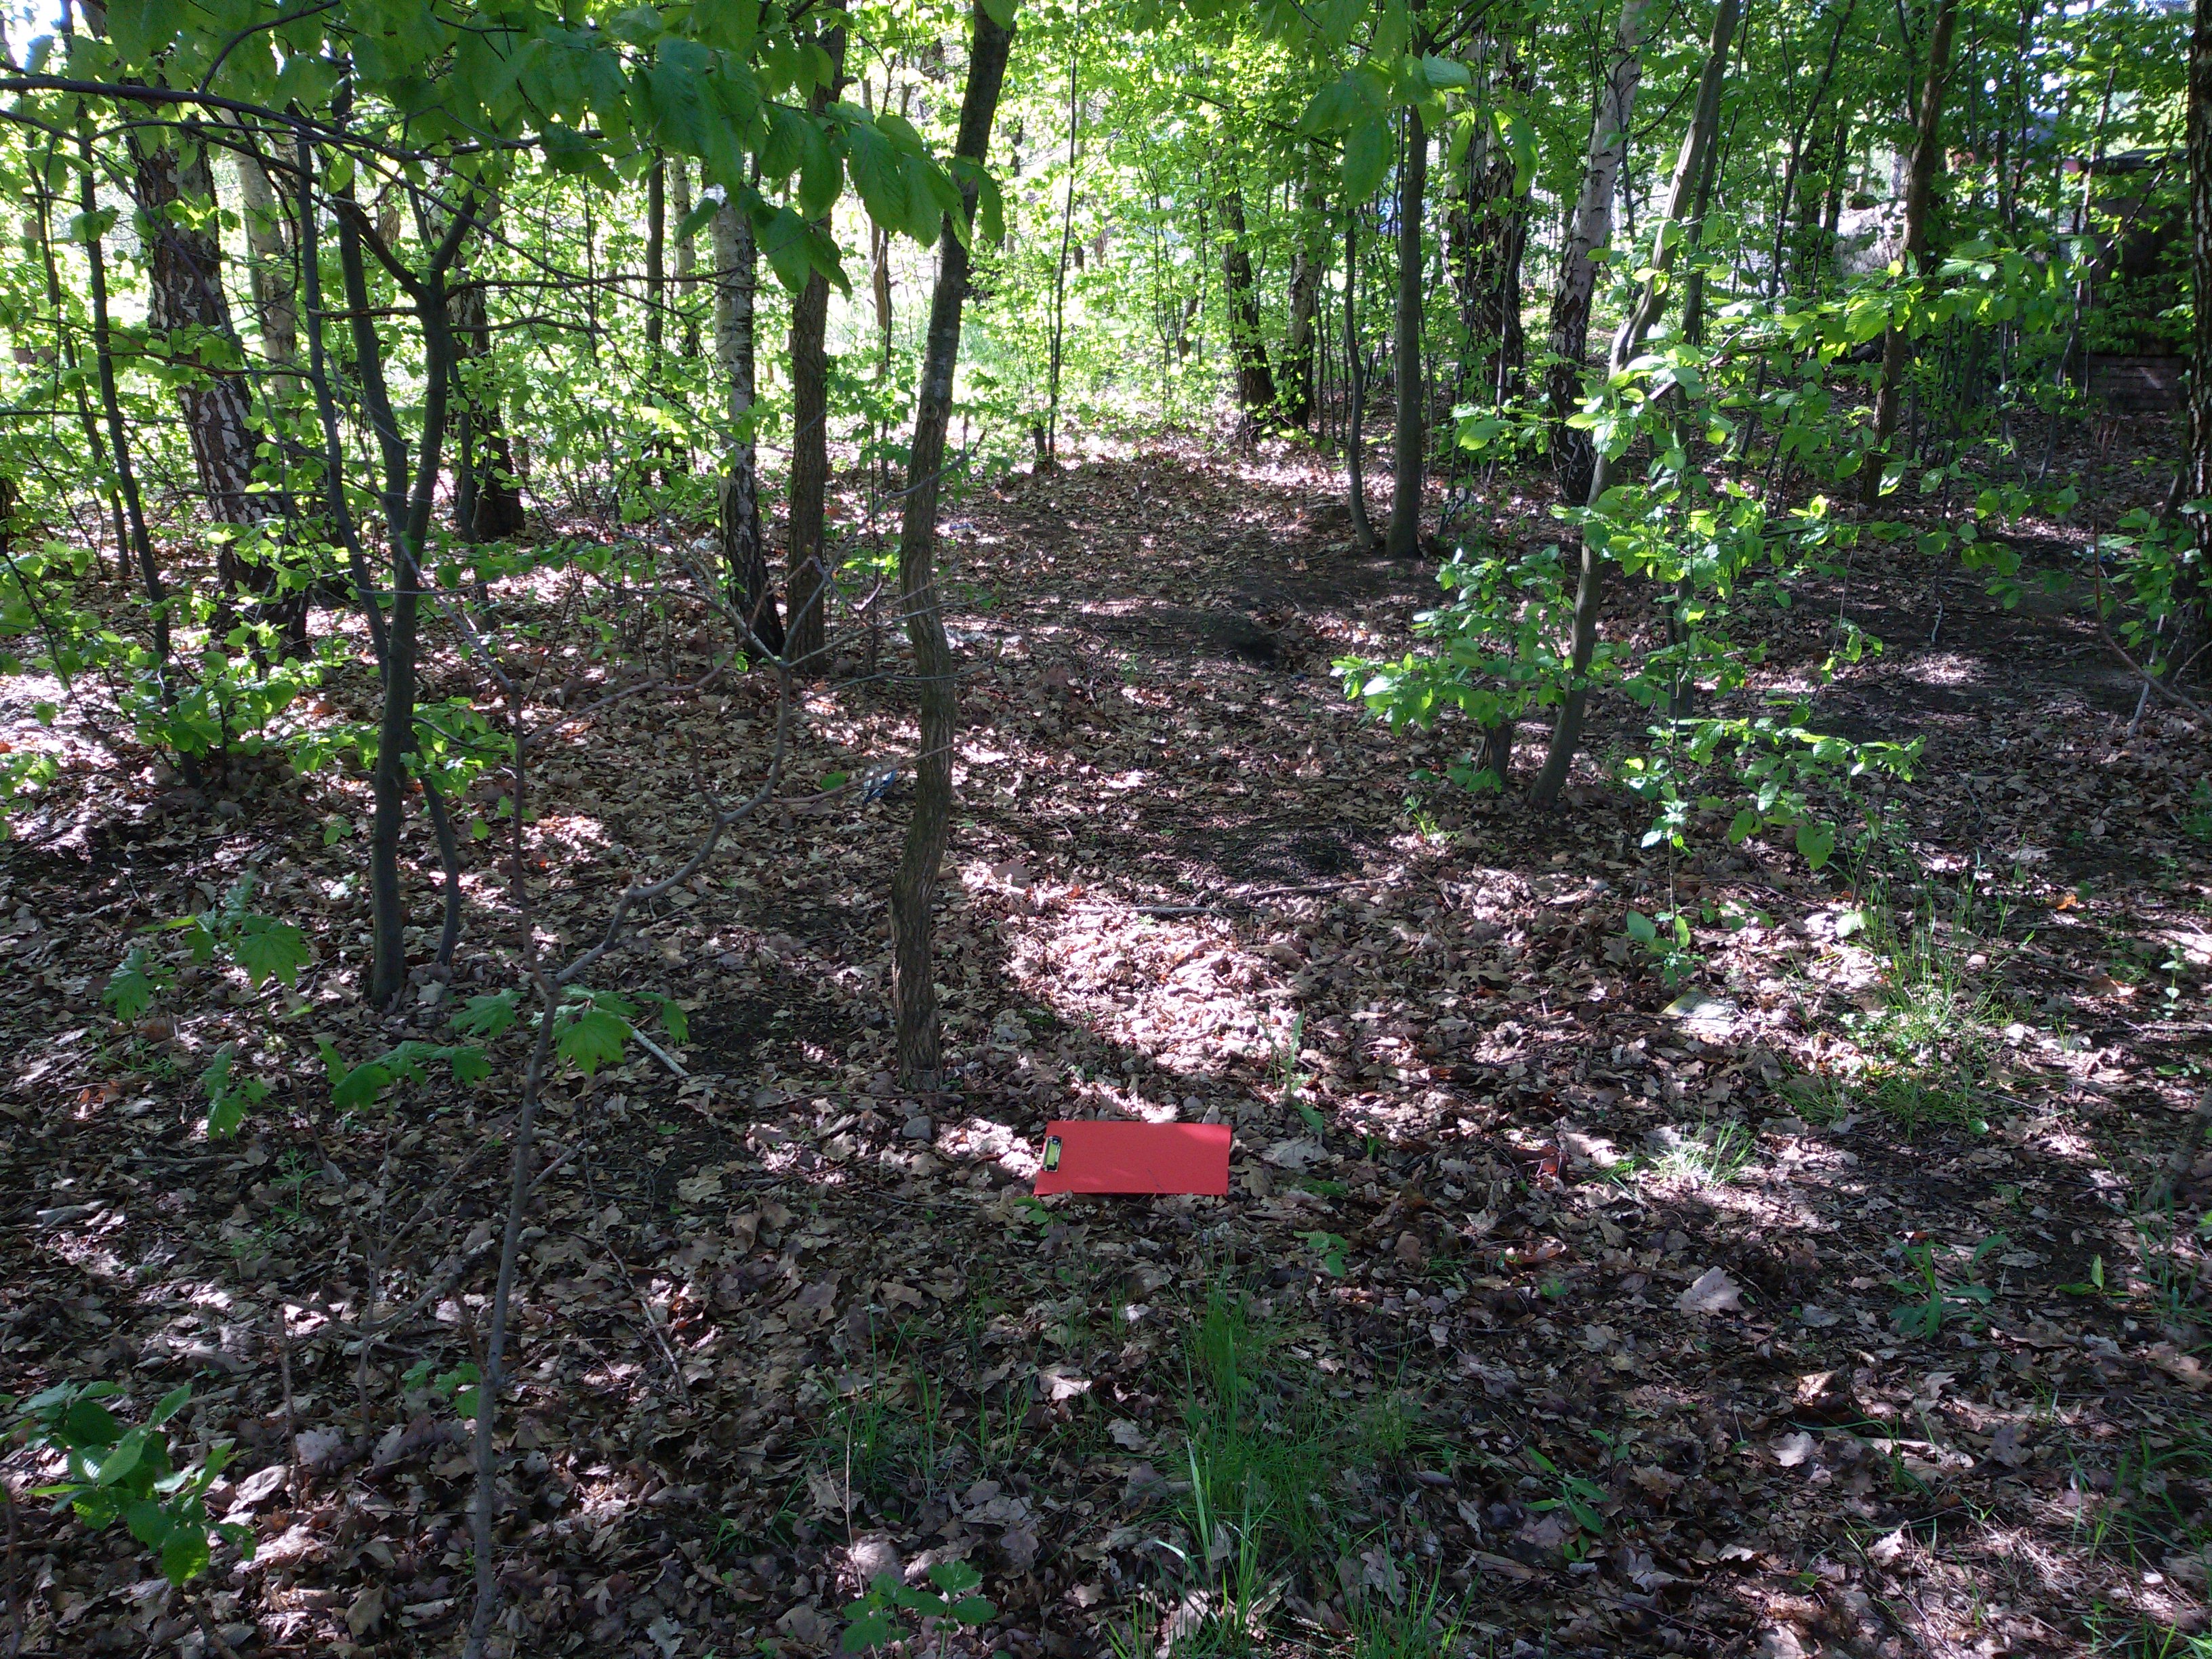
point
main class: Woodland
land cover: Broadleaved woodland
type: mesophytic deciduous forest
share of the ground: > 75 %
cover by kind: broadleaved forest trees 100 %
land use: Forestry
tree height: > 5 m
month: May
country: PL
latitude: 52.0101
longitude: 23.1166
